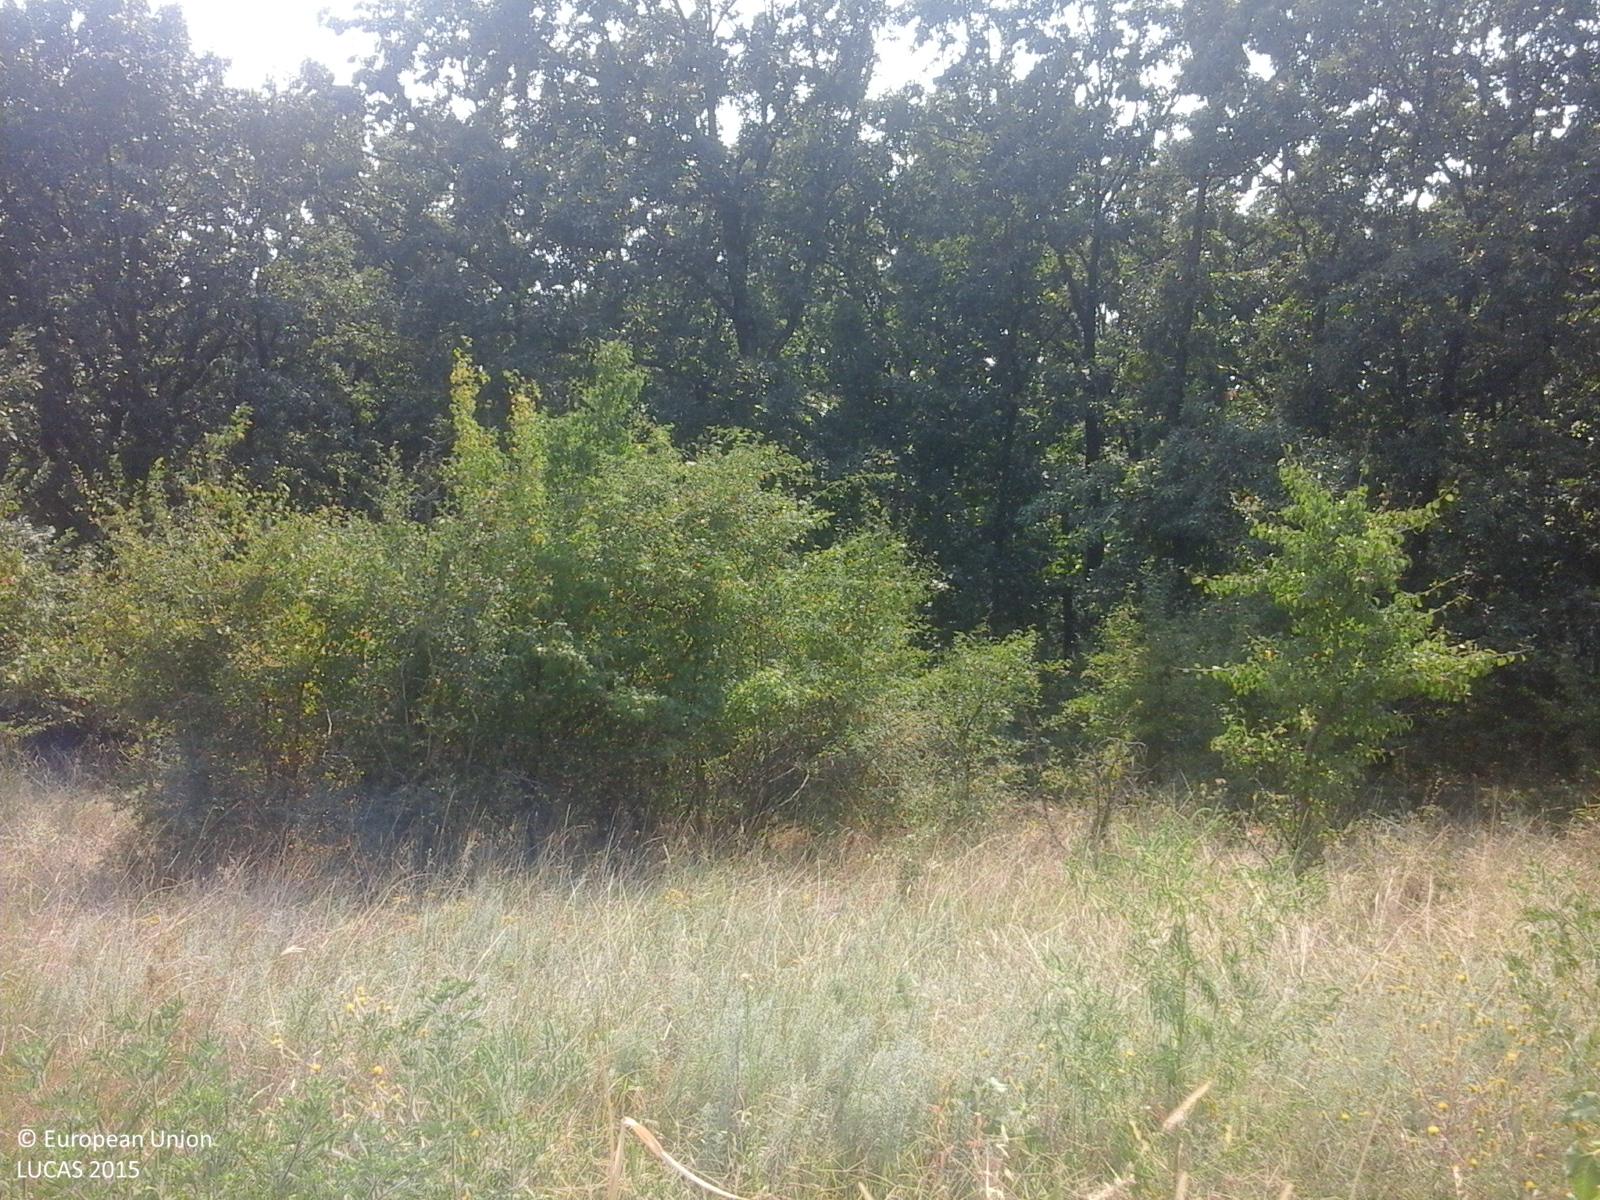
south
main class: Cropland
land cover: Sunflower
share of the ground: > 75 %
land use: Agriculture (excluding fallow land and kitchen gardens)
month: August
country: RO
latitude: 44.2179
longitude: 23.7357
